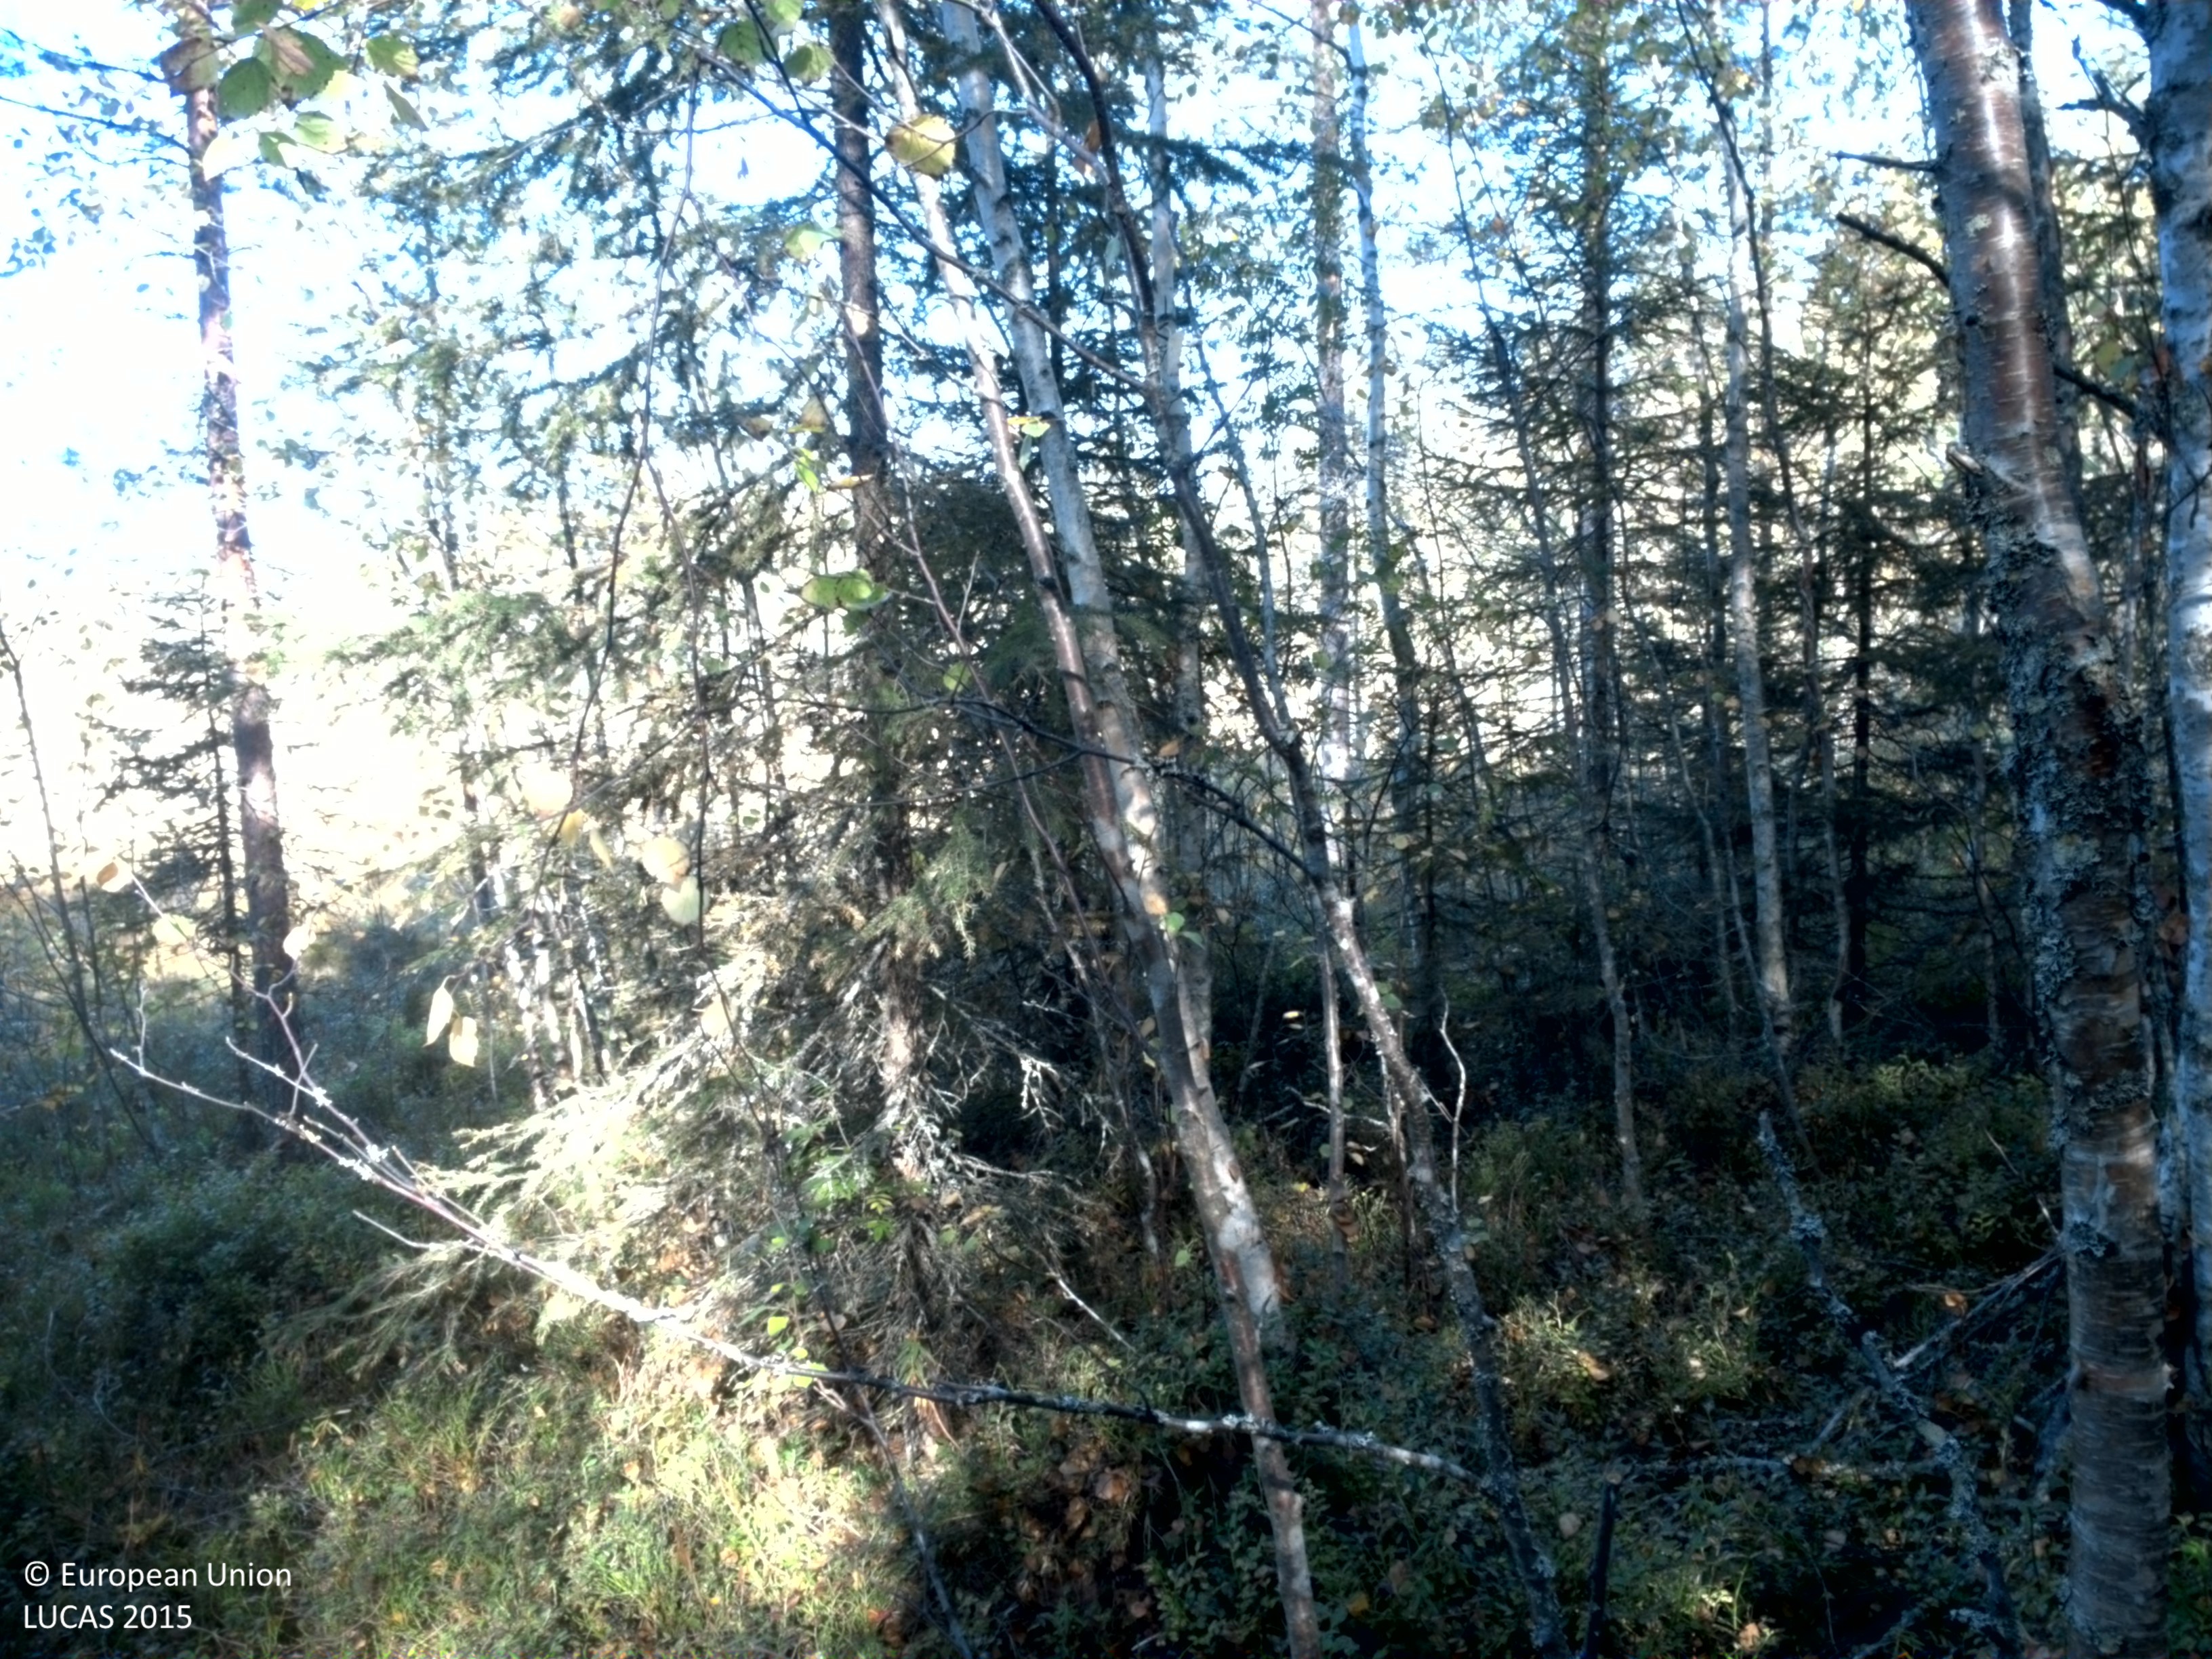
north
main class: Woodland
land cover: Spruce dominated mixed woodland
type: boreal forest
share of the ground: 25 - 50 %
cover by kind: shrubs 50 %, coniferous forest trees 25 %, broadleaved forest trees 25 %
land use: Forestry
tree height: > 5 m
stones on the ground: < 10 %
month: September
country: SE
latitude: 65.8235
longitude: 22.5634
